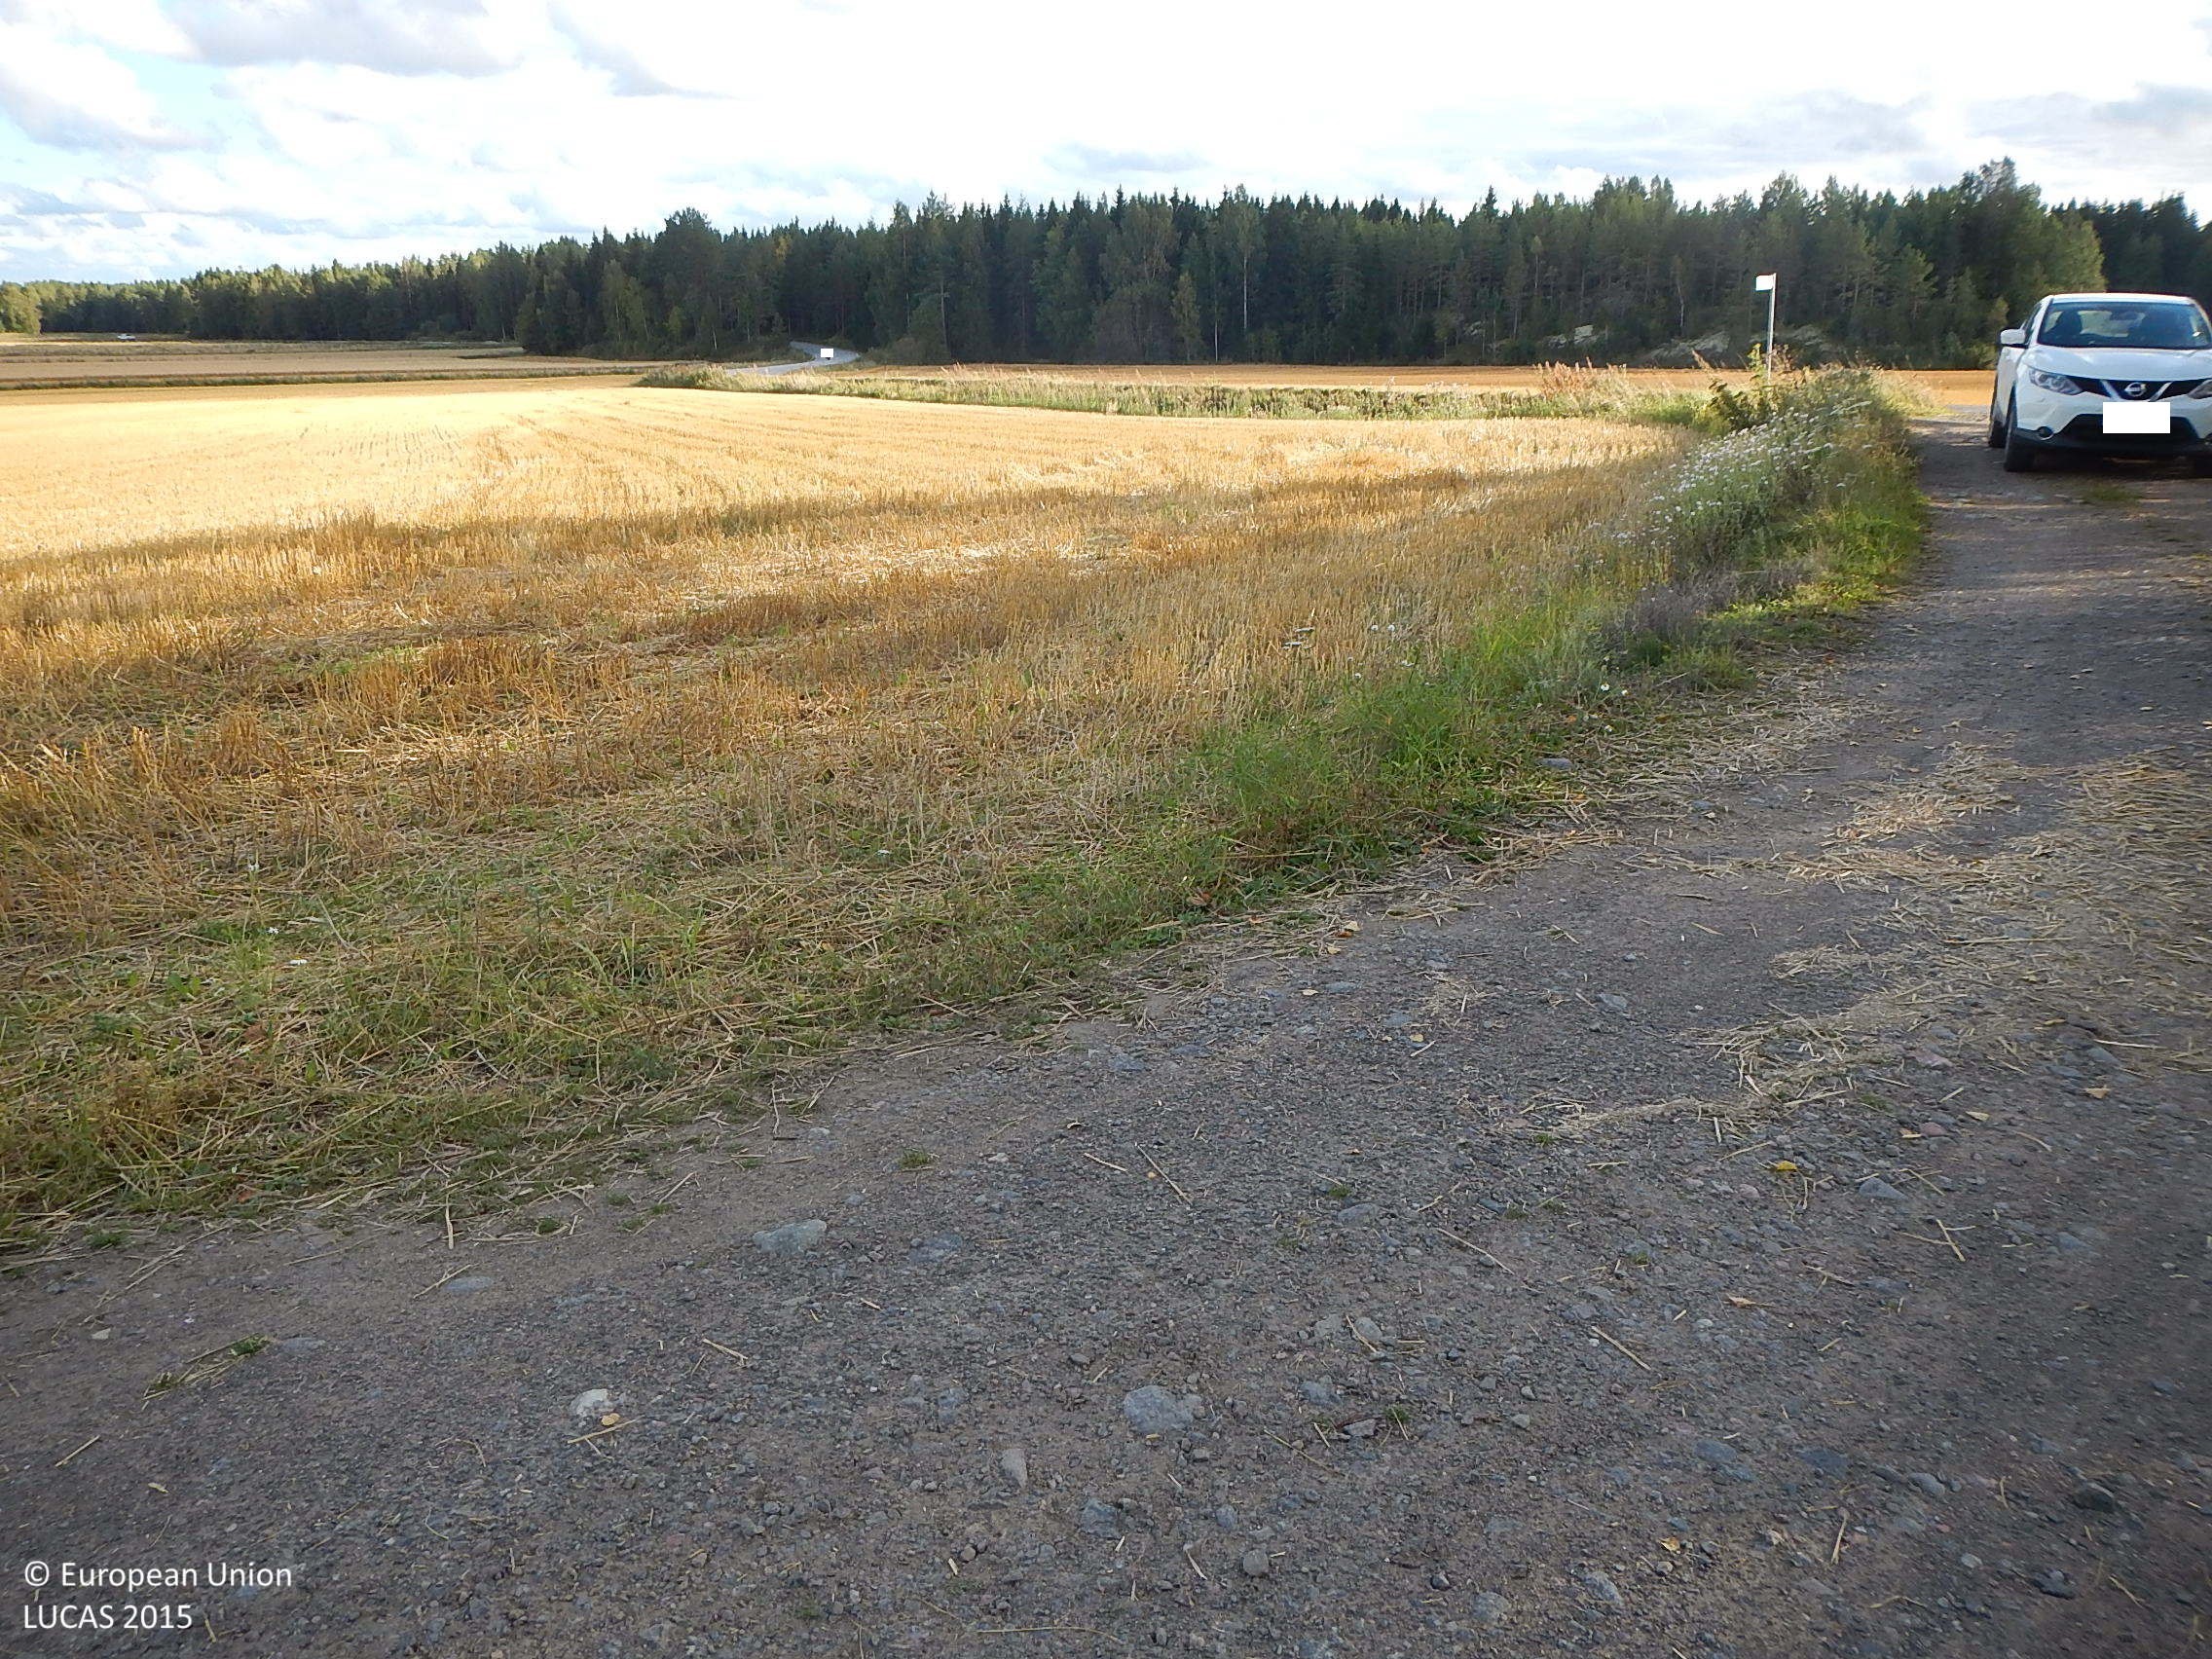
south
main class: Grassland
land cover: Spontaneously vegetated surfaces
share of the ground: > 75 %
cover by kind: herbaceous plants 100 %
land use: Fallow land
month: September
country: FI
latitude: 61.5011
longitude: 22.1006
